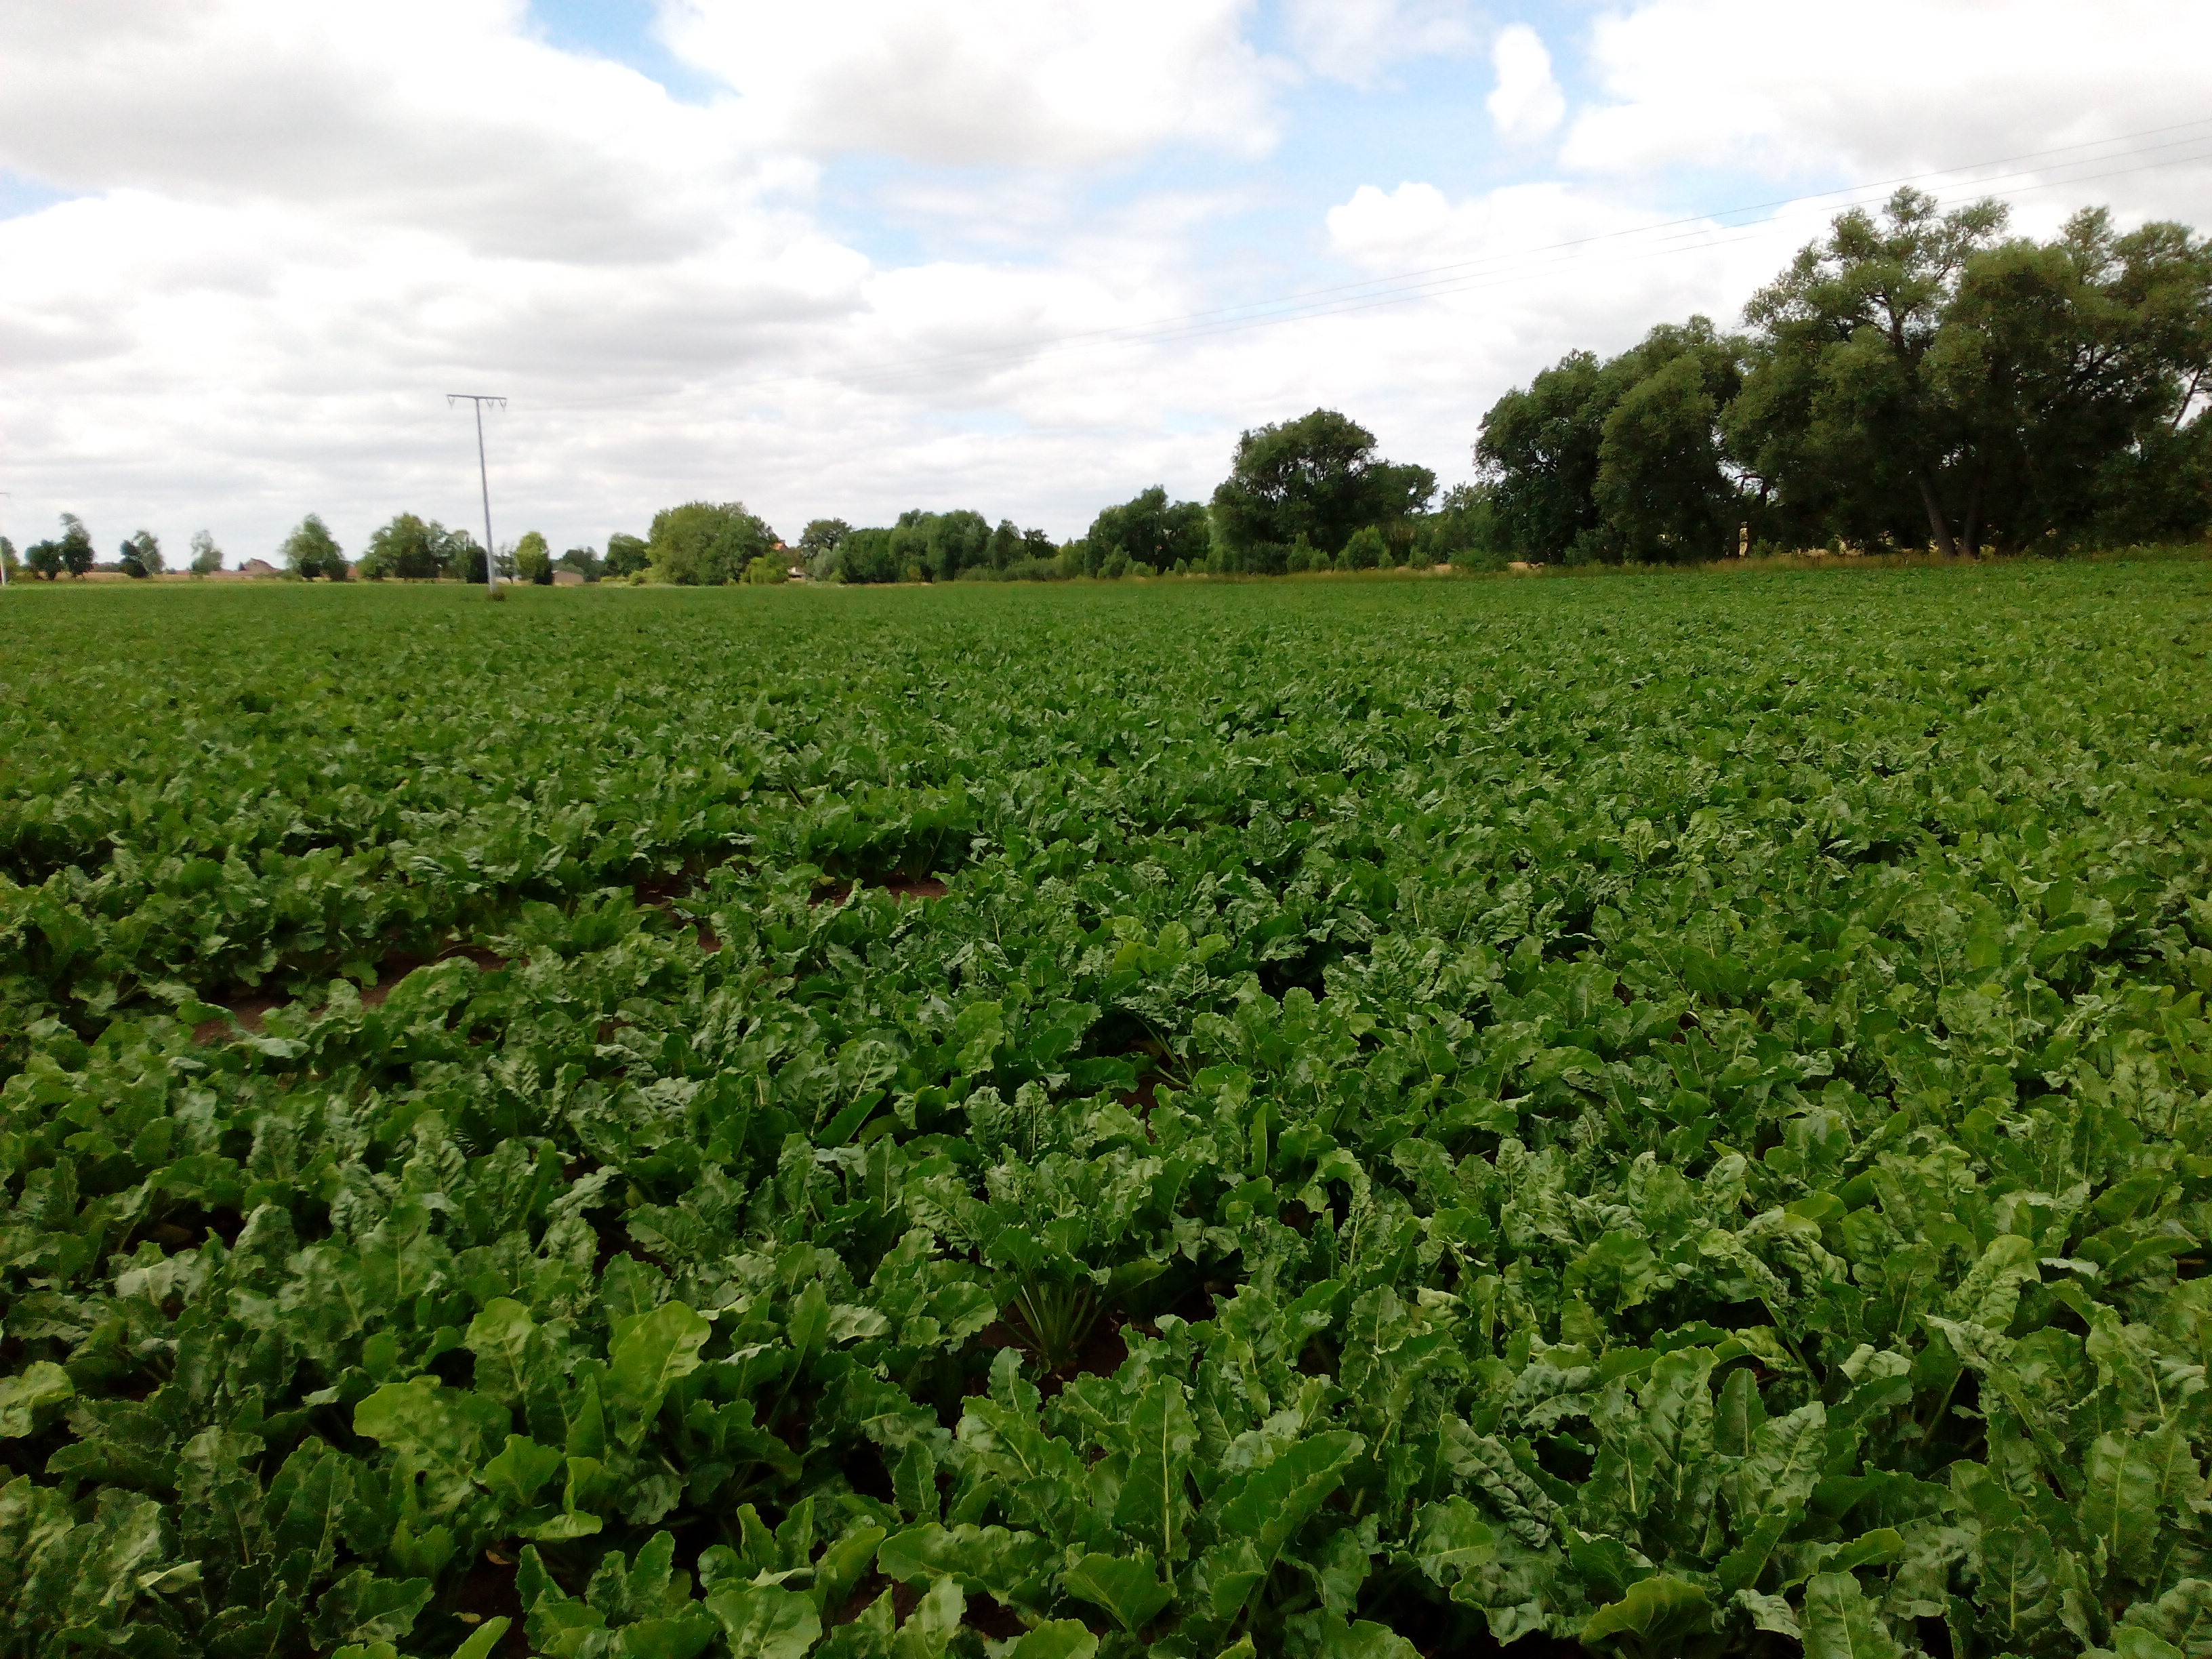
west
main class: Cropland
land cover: Sugar beet
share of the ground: > 75 %
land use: Agriculture (excluding fallow land and kitchen gardens)
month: July
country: DE
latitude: 51.1871
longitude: 10.9583
